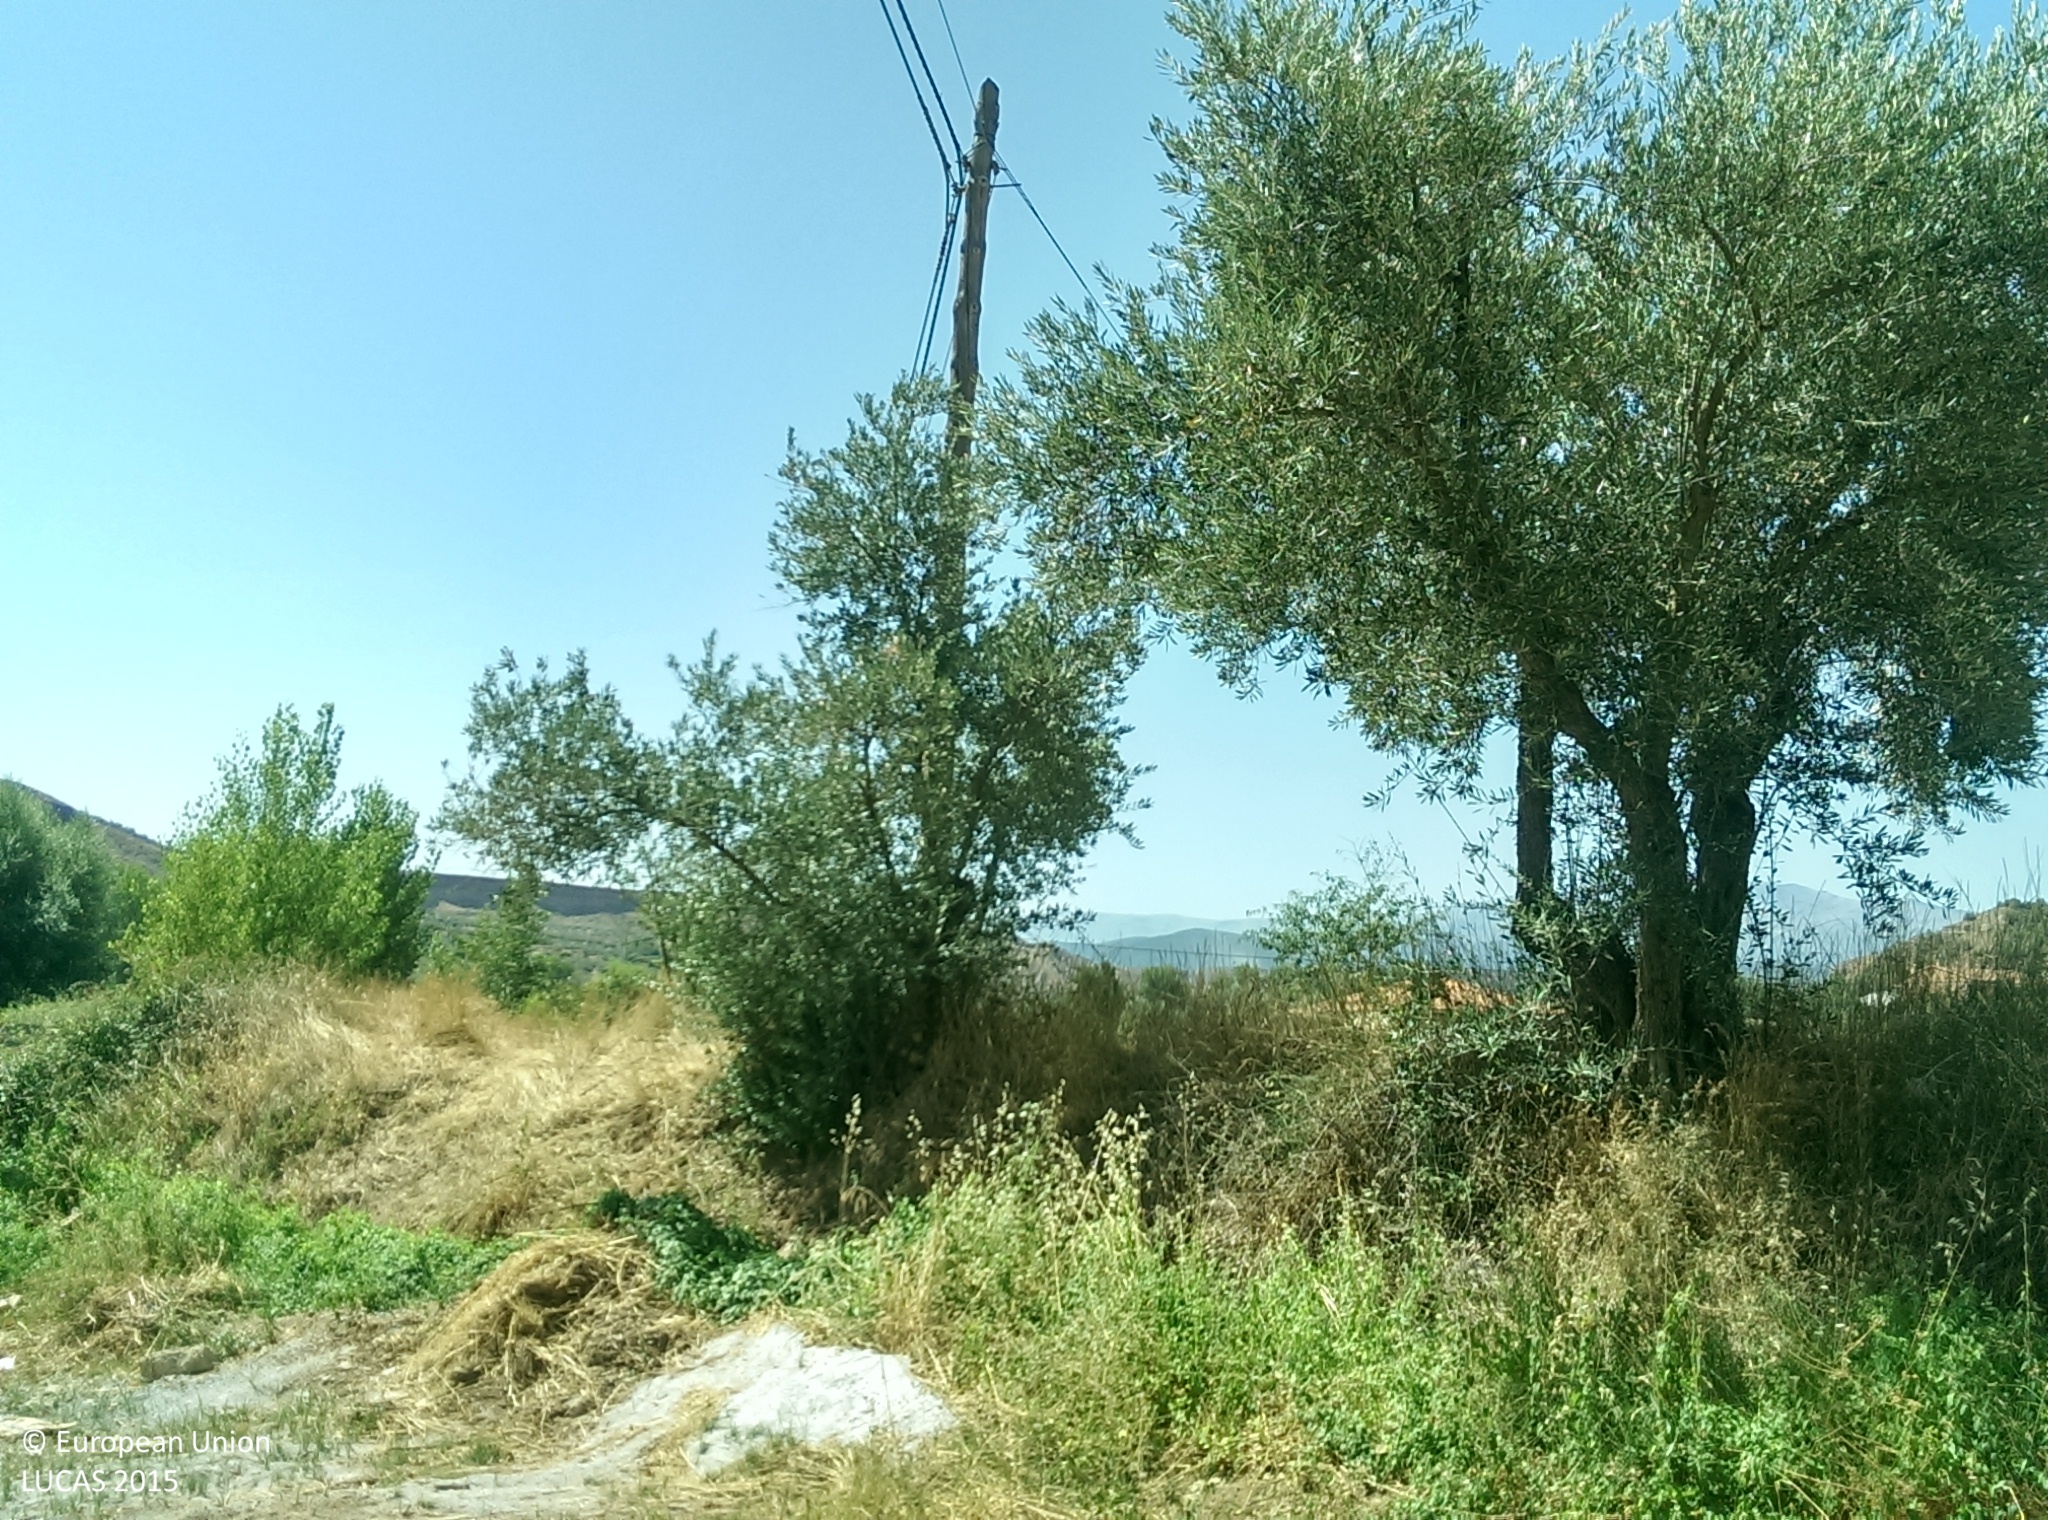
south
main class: Grassland
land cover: Spontaneously vegetated surfaces
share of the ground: 50 - 75 %
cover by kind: herbaceous plants 60 %, unconsolidated bare surface 40 %
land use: Fallow land
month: July
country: ES
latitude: 37.3004
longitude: -3.1983
